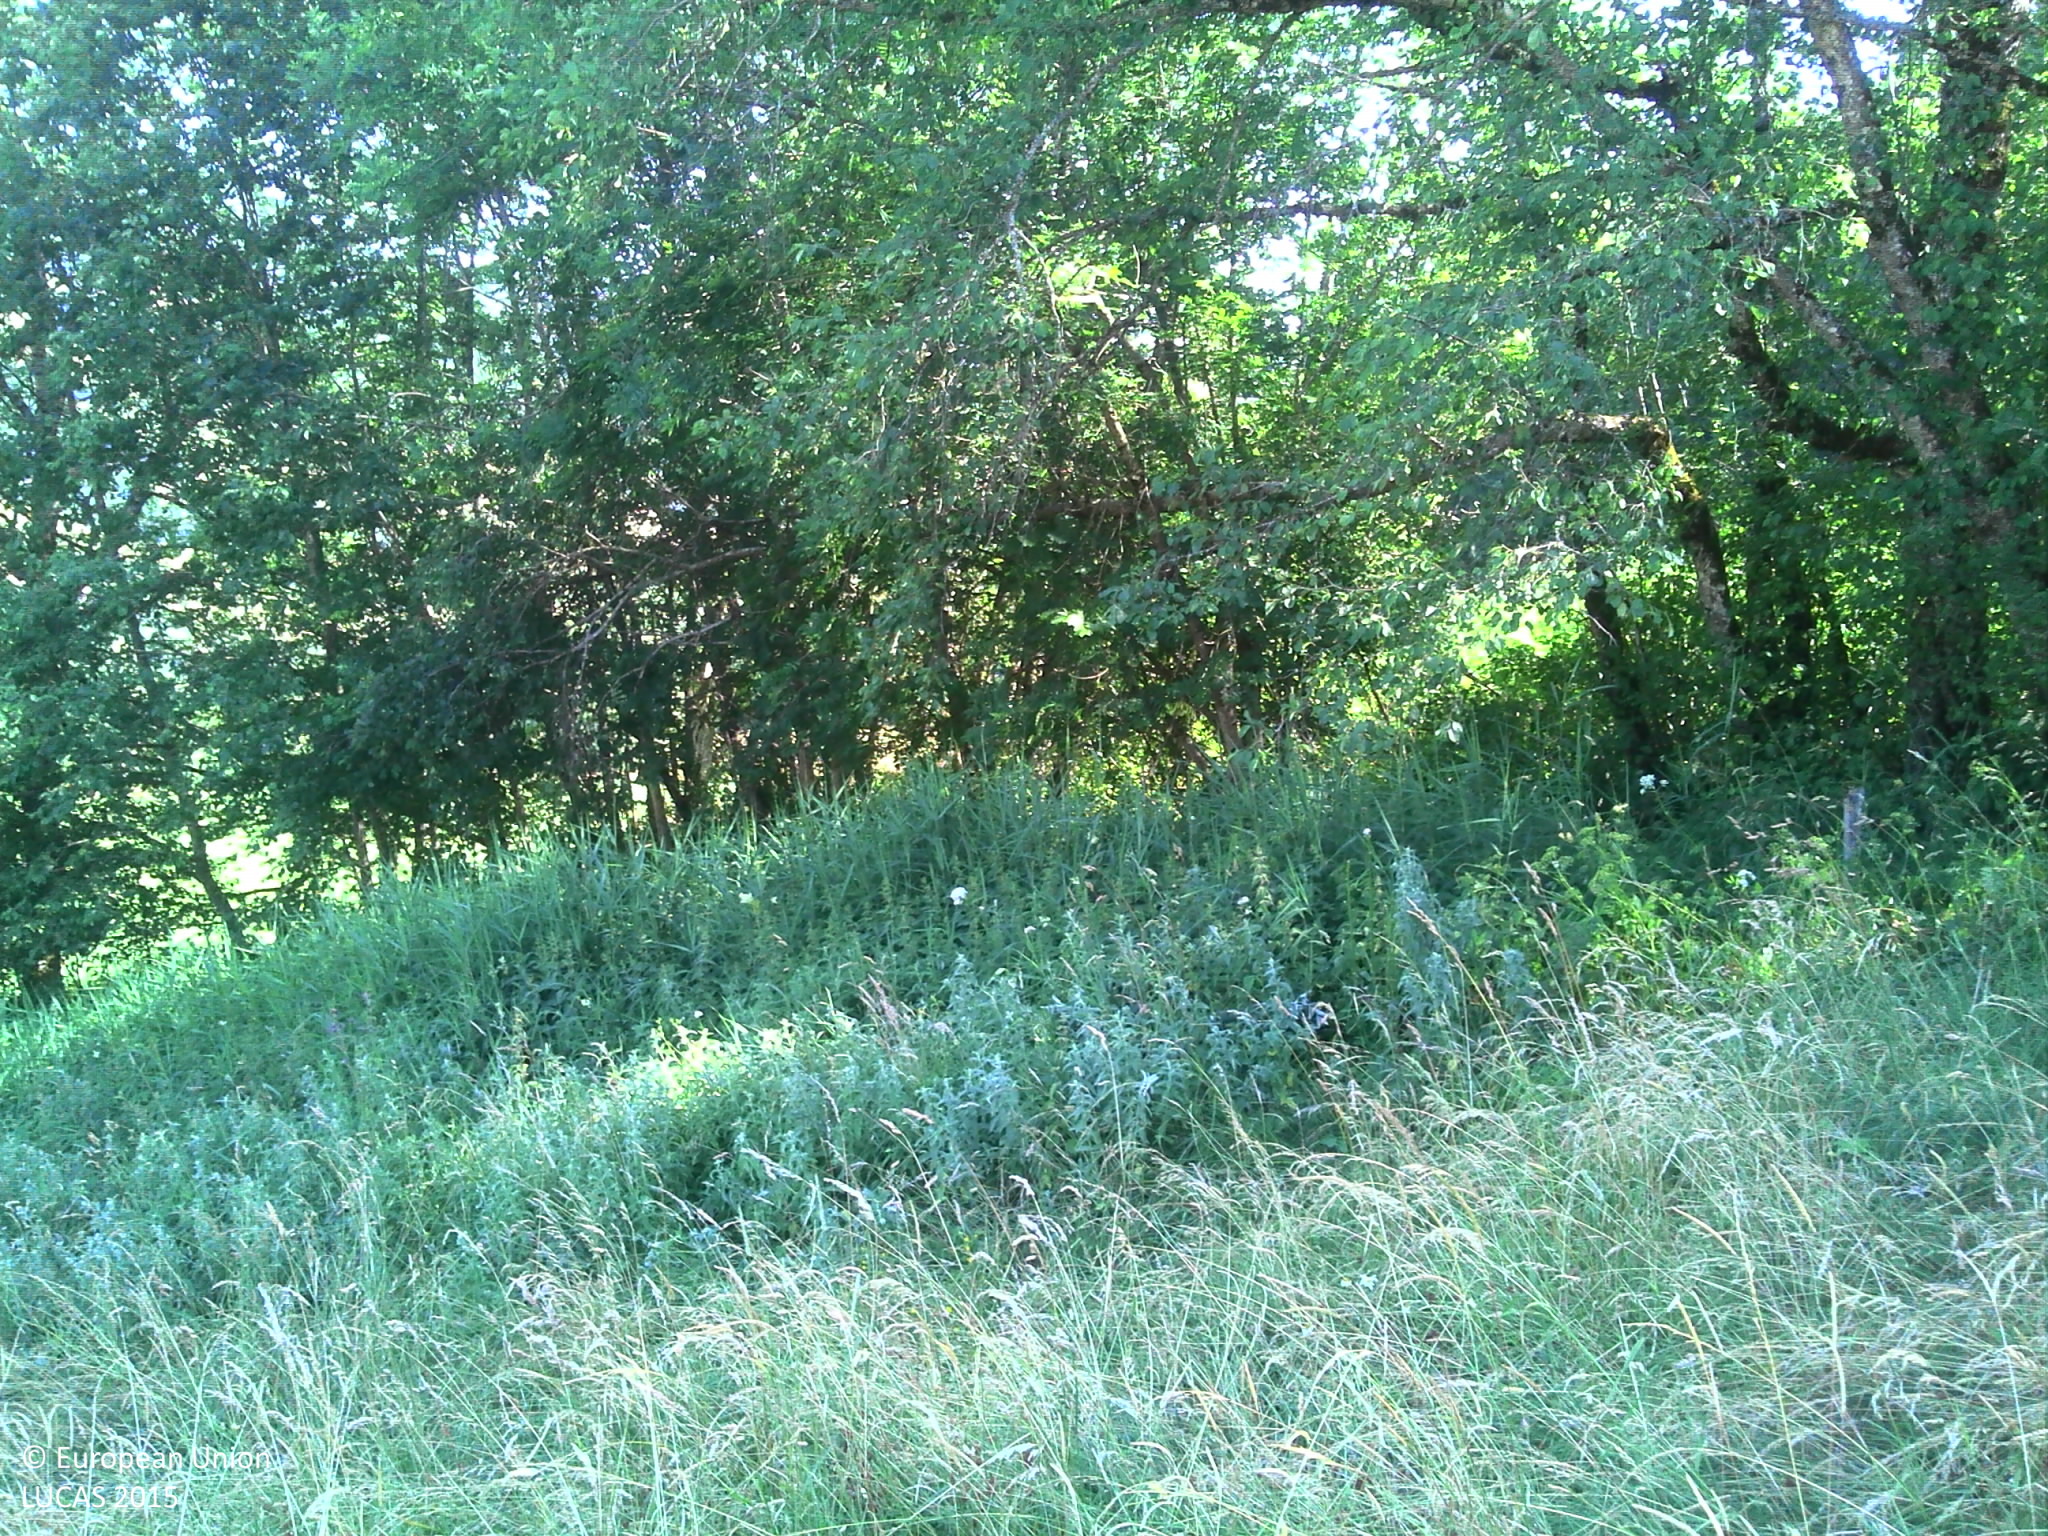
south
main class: Grassland
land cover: Grassland without tree/shrub cover
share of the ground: > 75 %
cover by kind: herbaceous plants 100 %
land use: Agriculture (excluding fallow land and kitchen gardens)
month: July
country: FR
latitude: 46.2378
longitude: 6.4372
